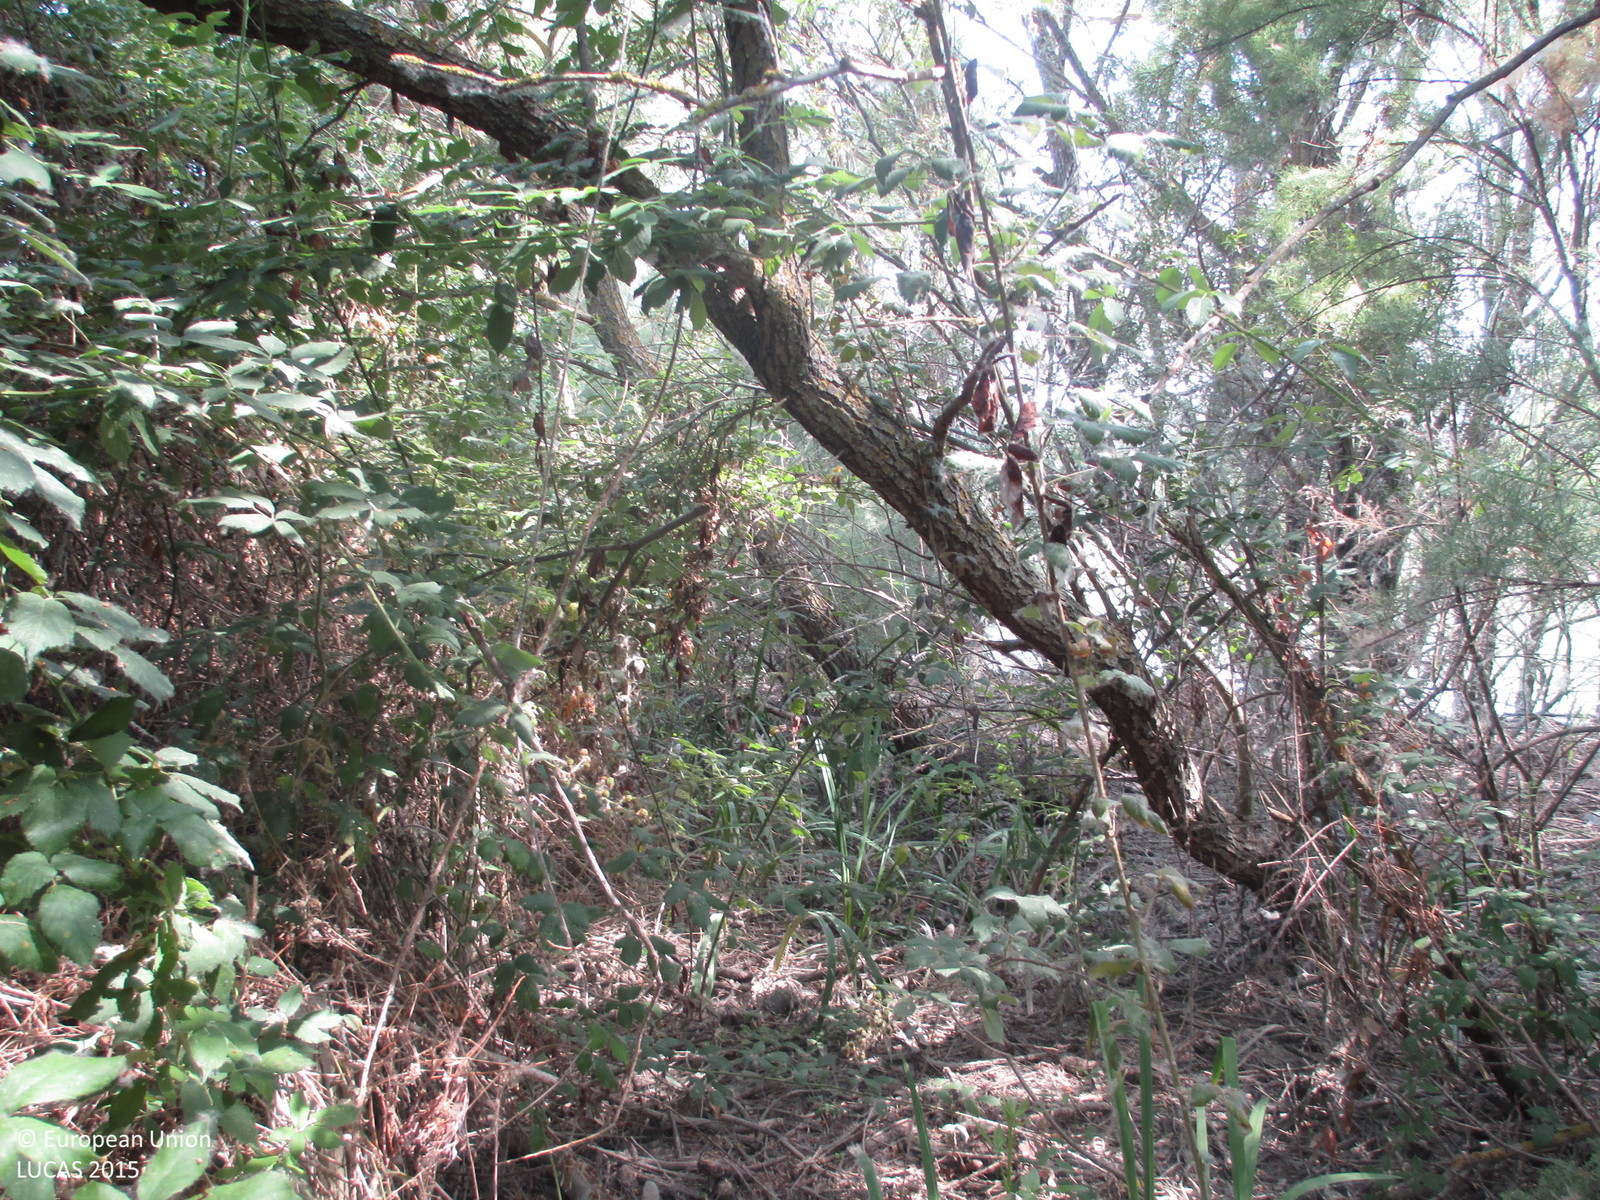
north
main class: Woodland
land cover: Broadleaved woodland
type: floodplain forest
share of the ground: > 75 %
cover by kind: broadleaved forest trees 100 %
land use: Semi-natural and natural areas not in use
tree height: > 5 m
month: July
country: ES
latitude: 42.1725
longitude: 0.3337
